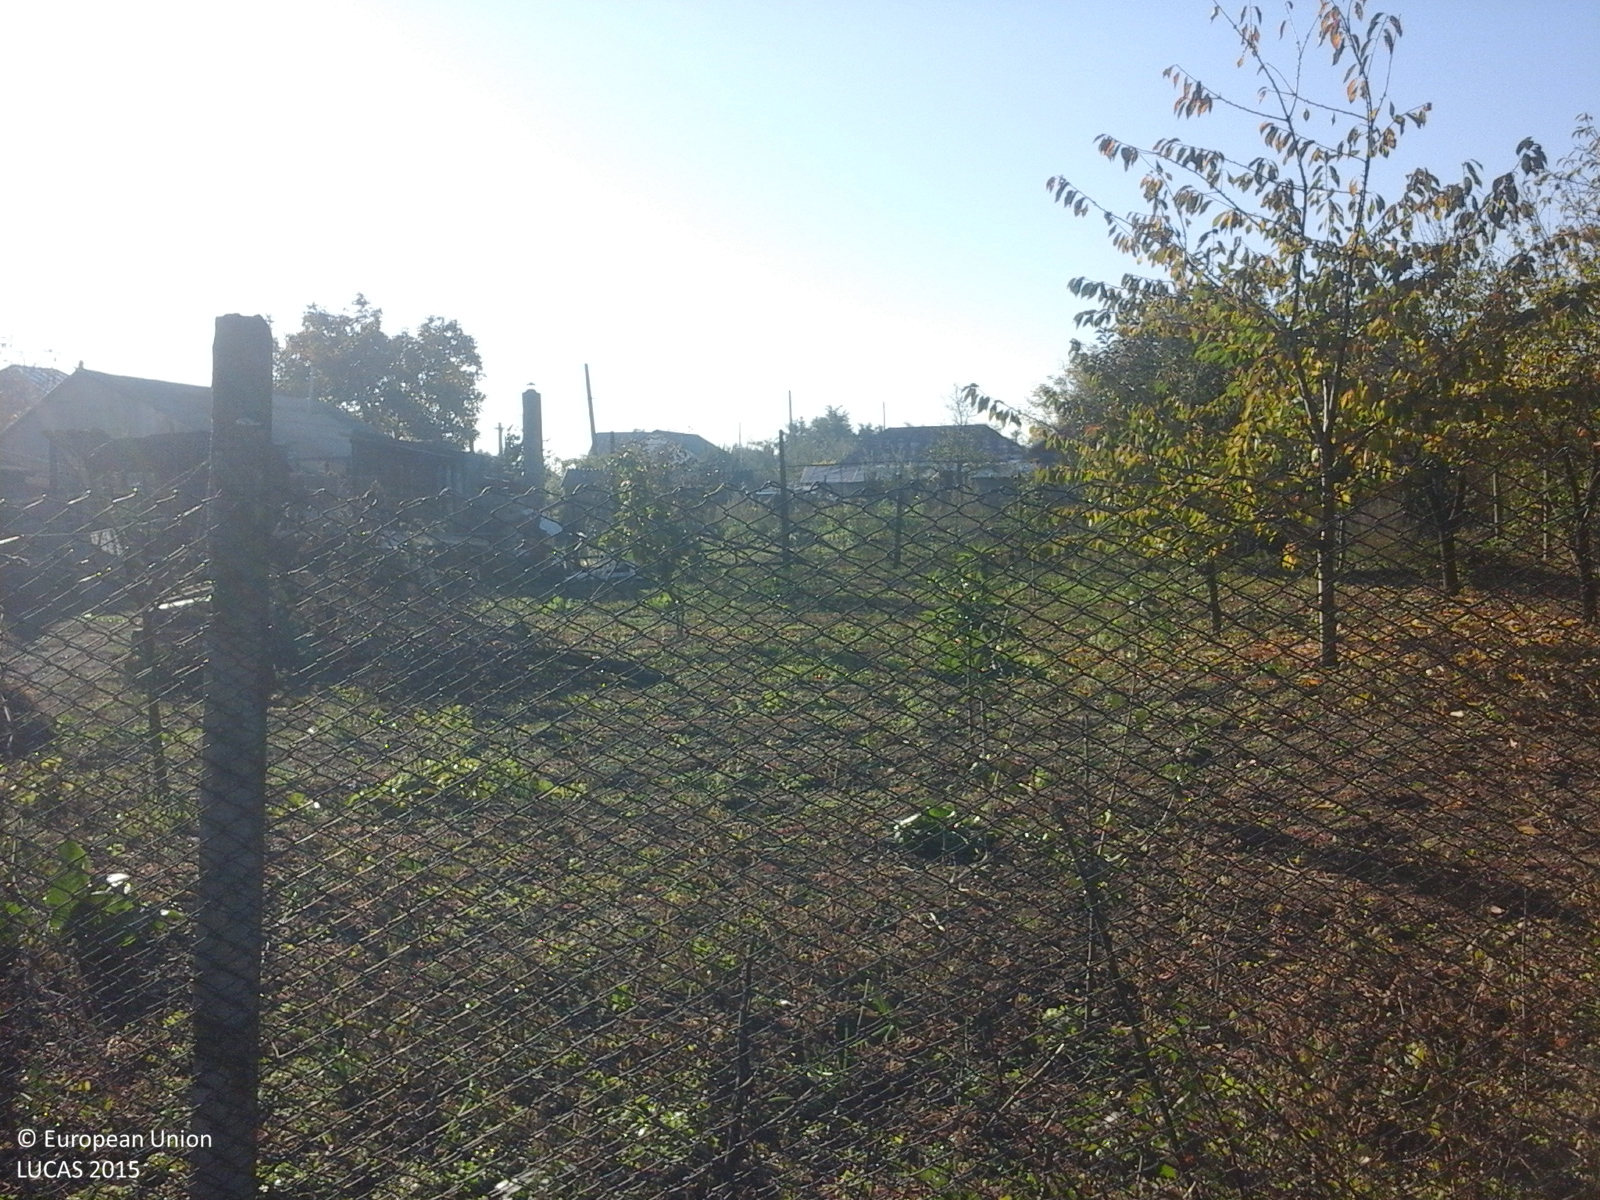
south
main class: Cropland
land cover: Nuts trees
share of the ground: 50 - 75 %
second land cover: Grassland without tree/shrub cover
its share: 25 - 50 %
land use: Agriculture (excluding fallow land and kitchen gardens)
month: October
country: RO
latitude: 45.9185
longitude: 27.2070
